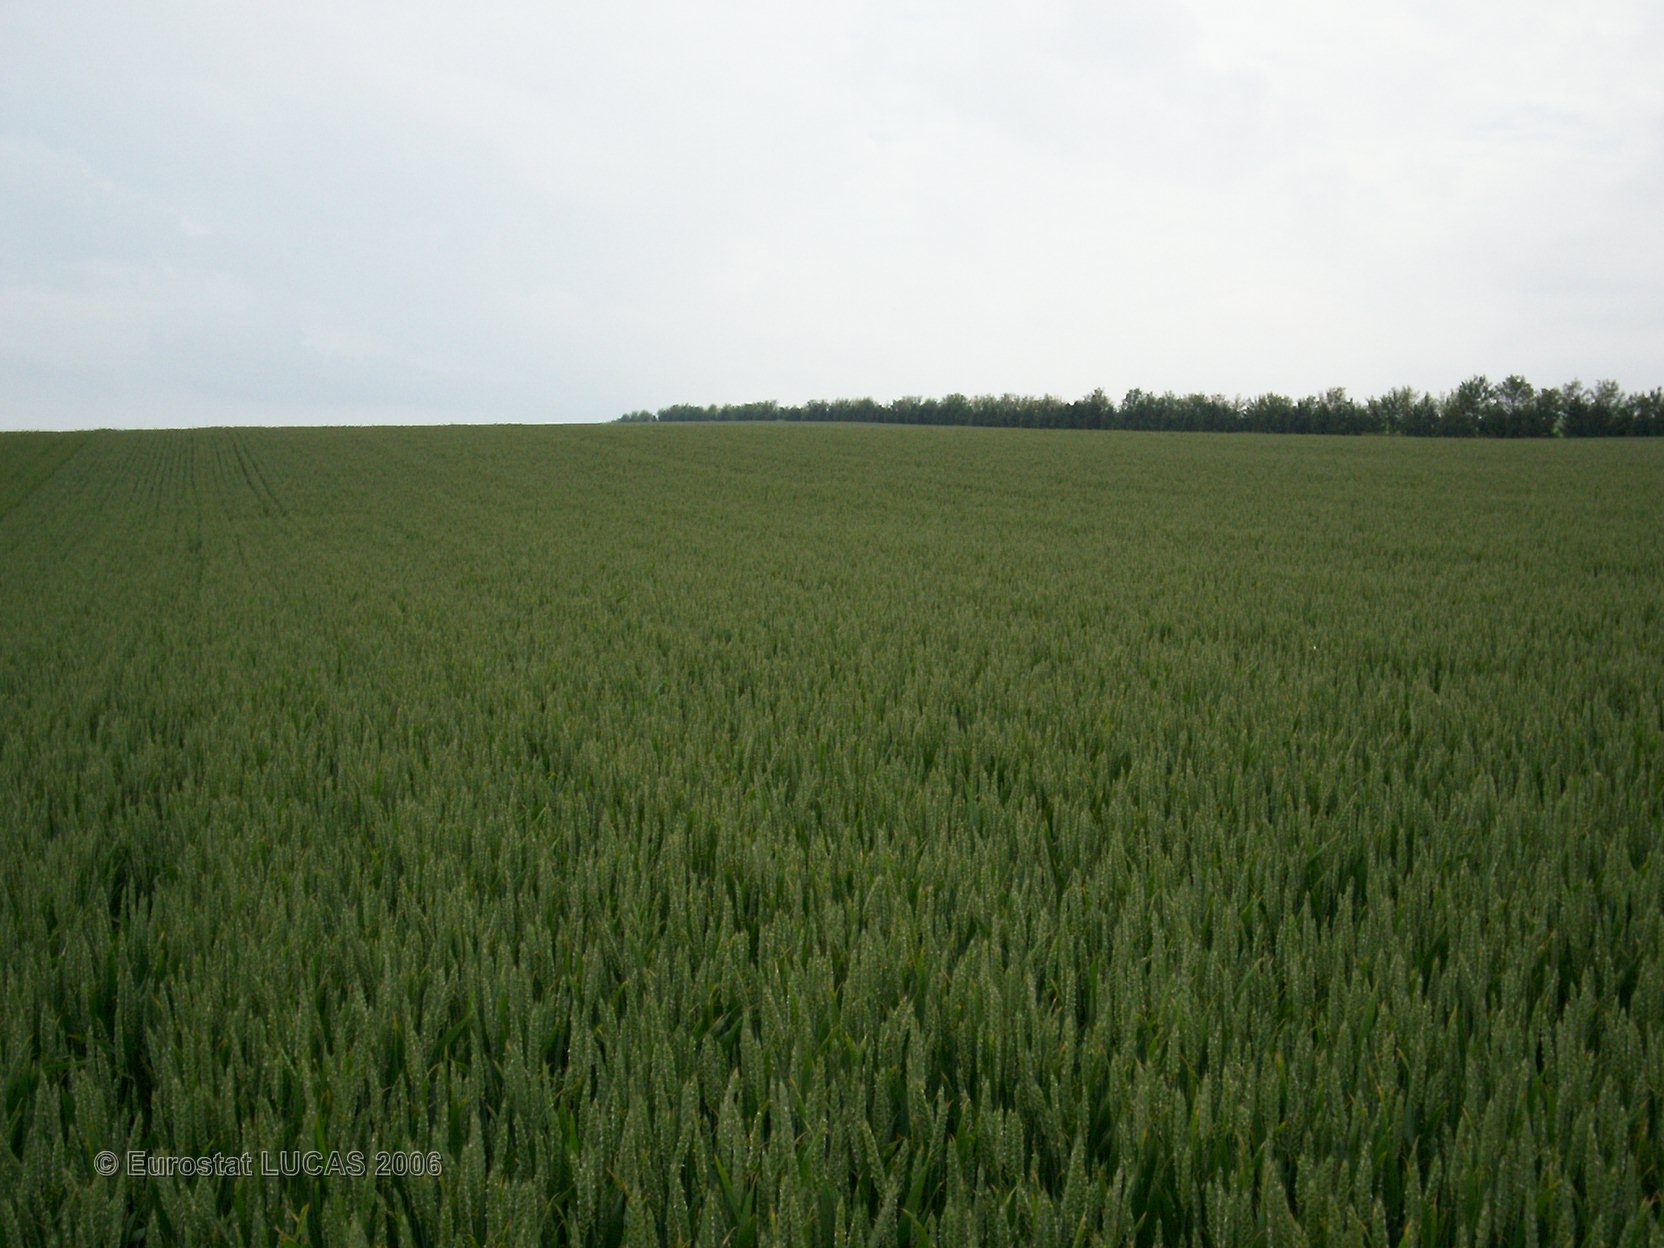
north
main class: Cropland
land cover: Common wheat
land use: Agriculture (excluding fallow land and kitchen gardens)
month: June
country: FR
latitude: 48.7529
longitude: 4.4882
